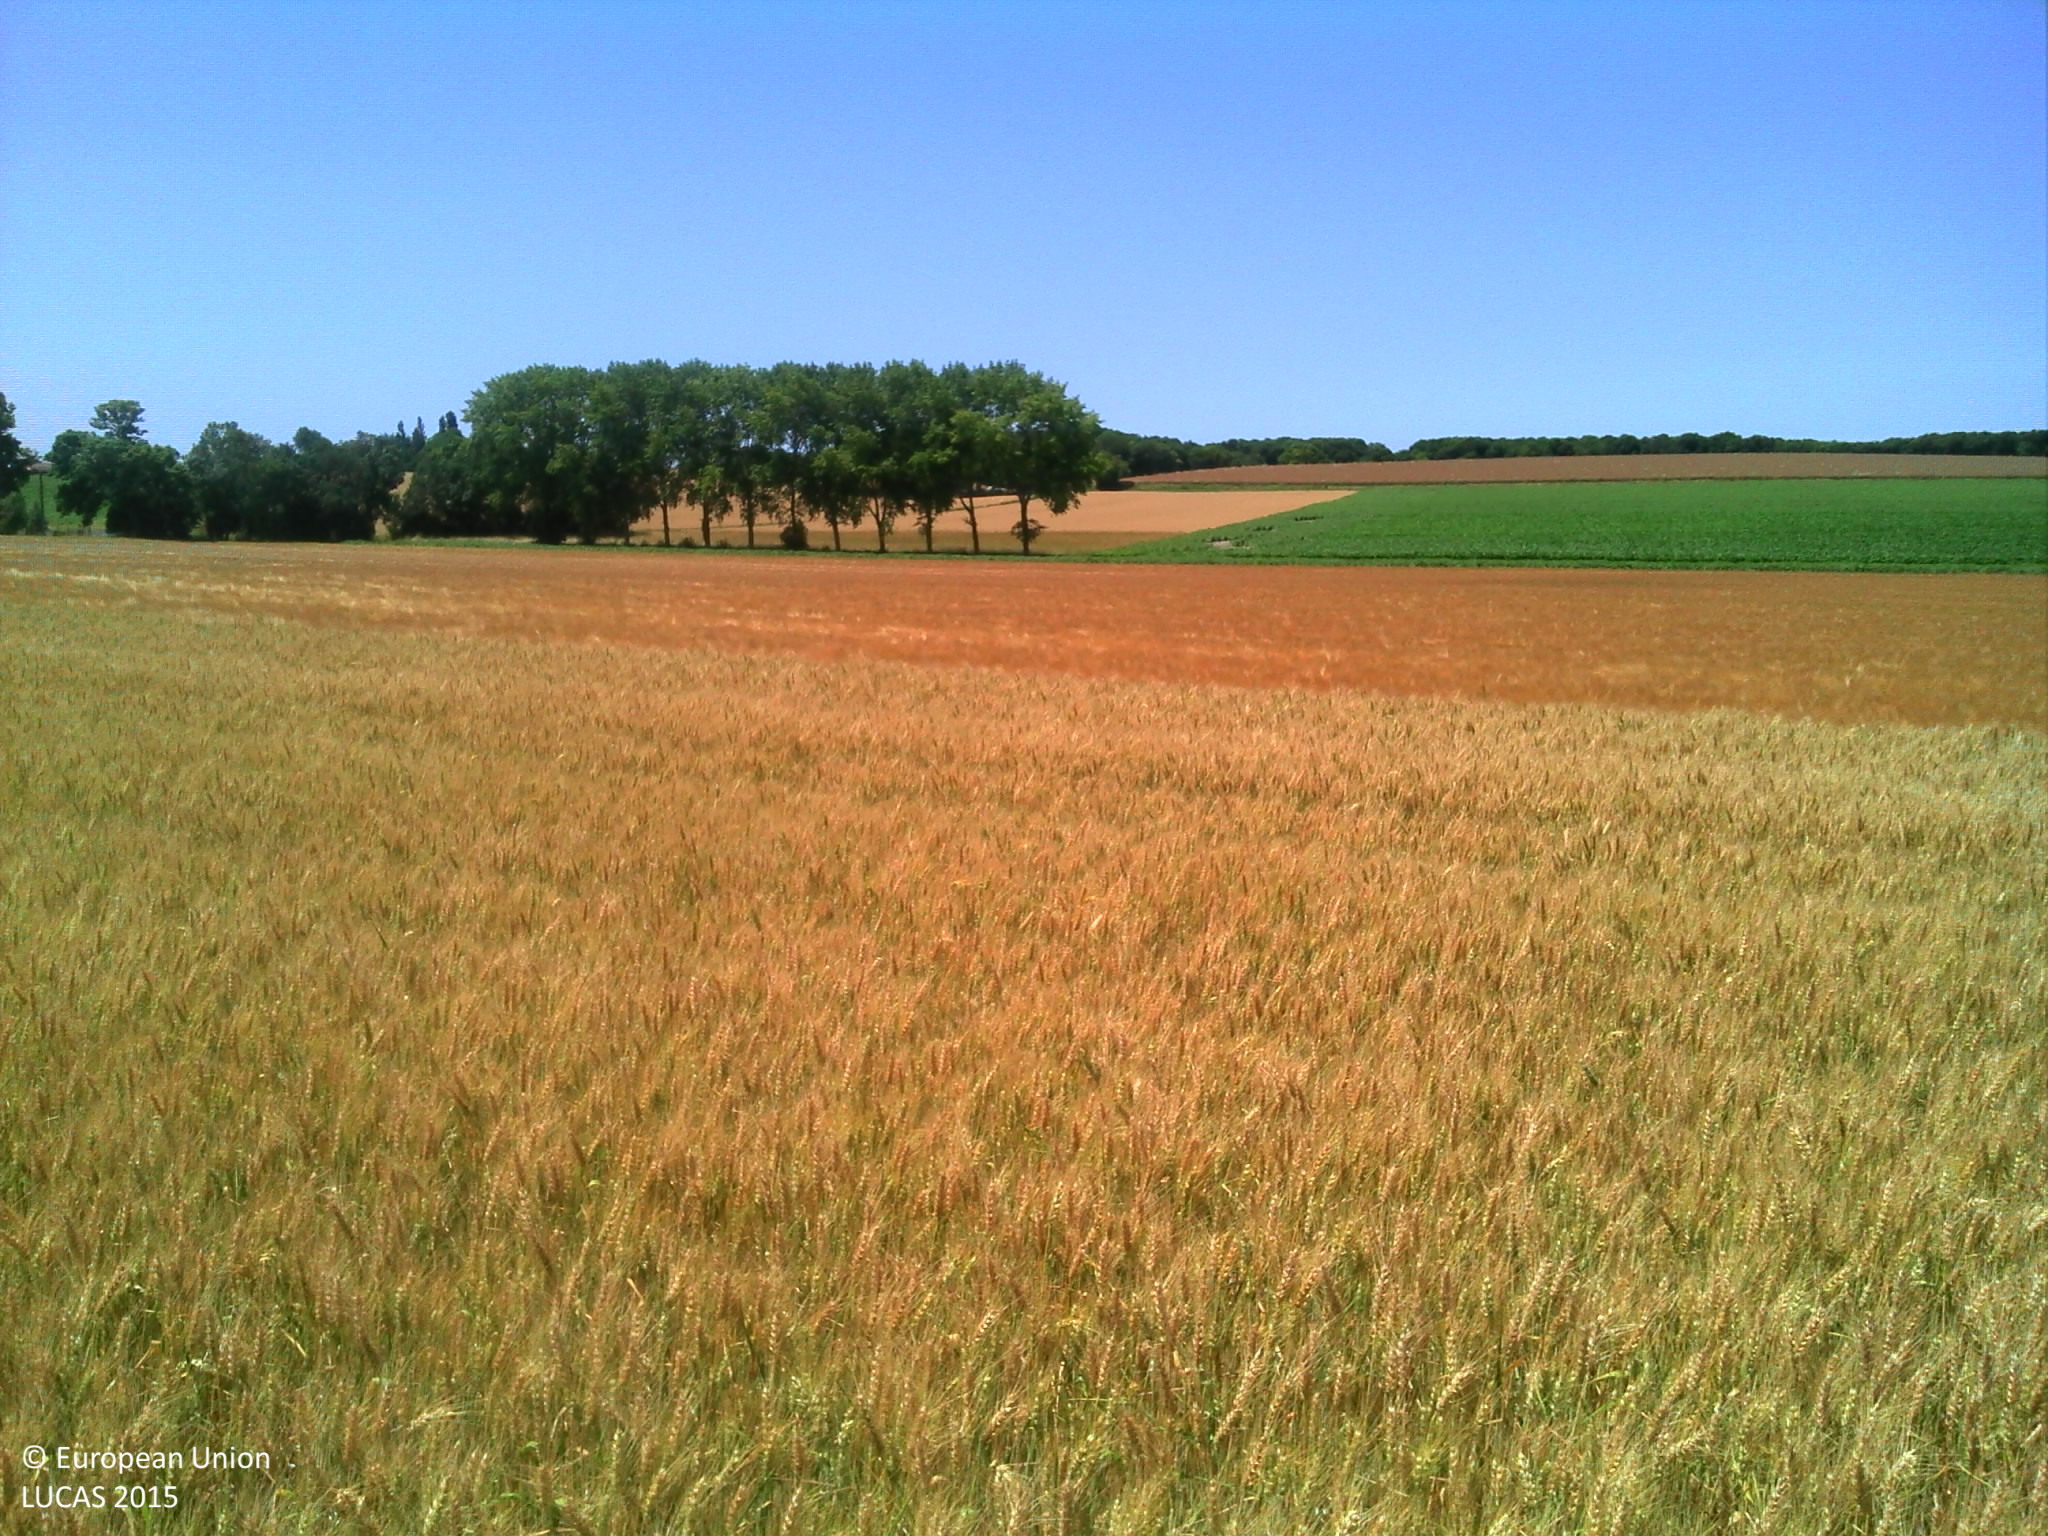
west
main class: Cropland
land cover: Durum wheat
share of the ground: > 75 %
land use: Agriculture (excluding fallow land and kitchen gardens)
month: June
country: FR
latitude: 45.5613
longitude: -0.8512
